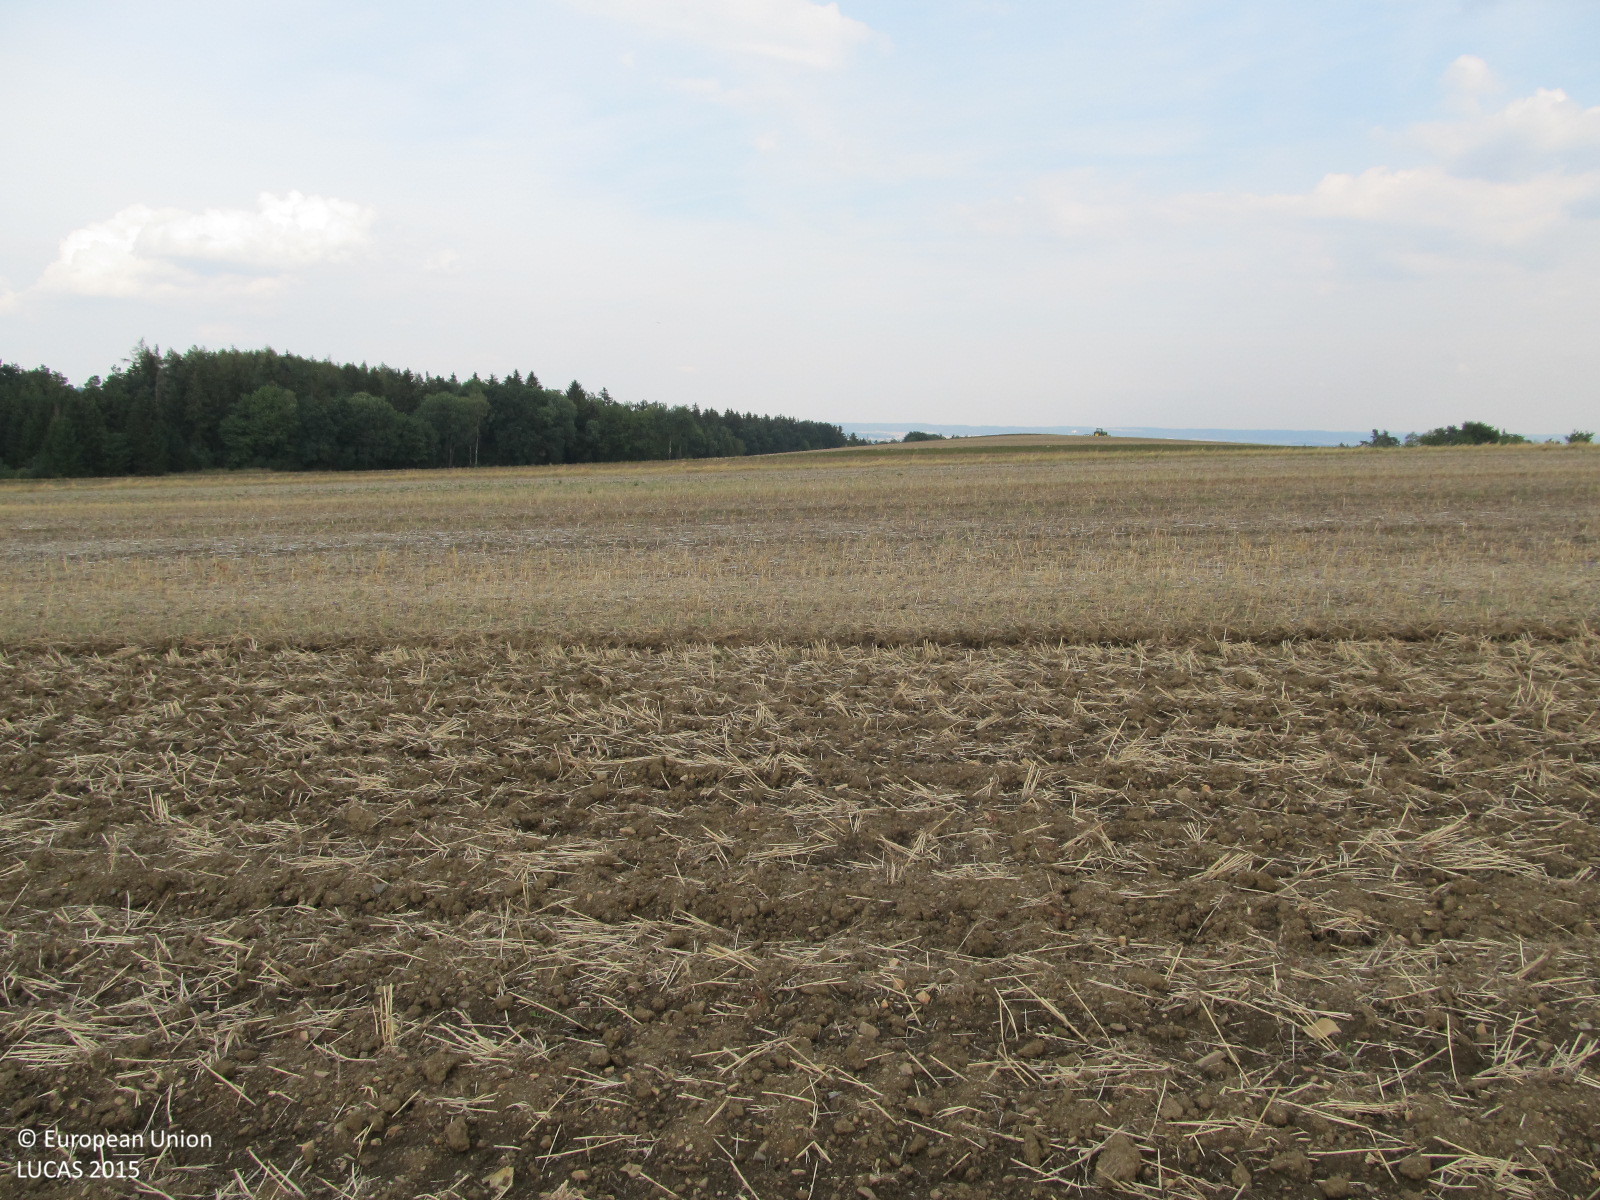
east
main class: Cropland
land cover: Barley
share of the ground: < 10 %
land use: Agriculture (excluding fallow land and kitchen gardens)
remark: Harvested field
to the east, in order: Barley; Grass margins; Tracks; Grass margins; Rye; Temporary grasslands
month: August
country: AT
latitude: 48.6992
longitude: 15.5058
